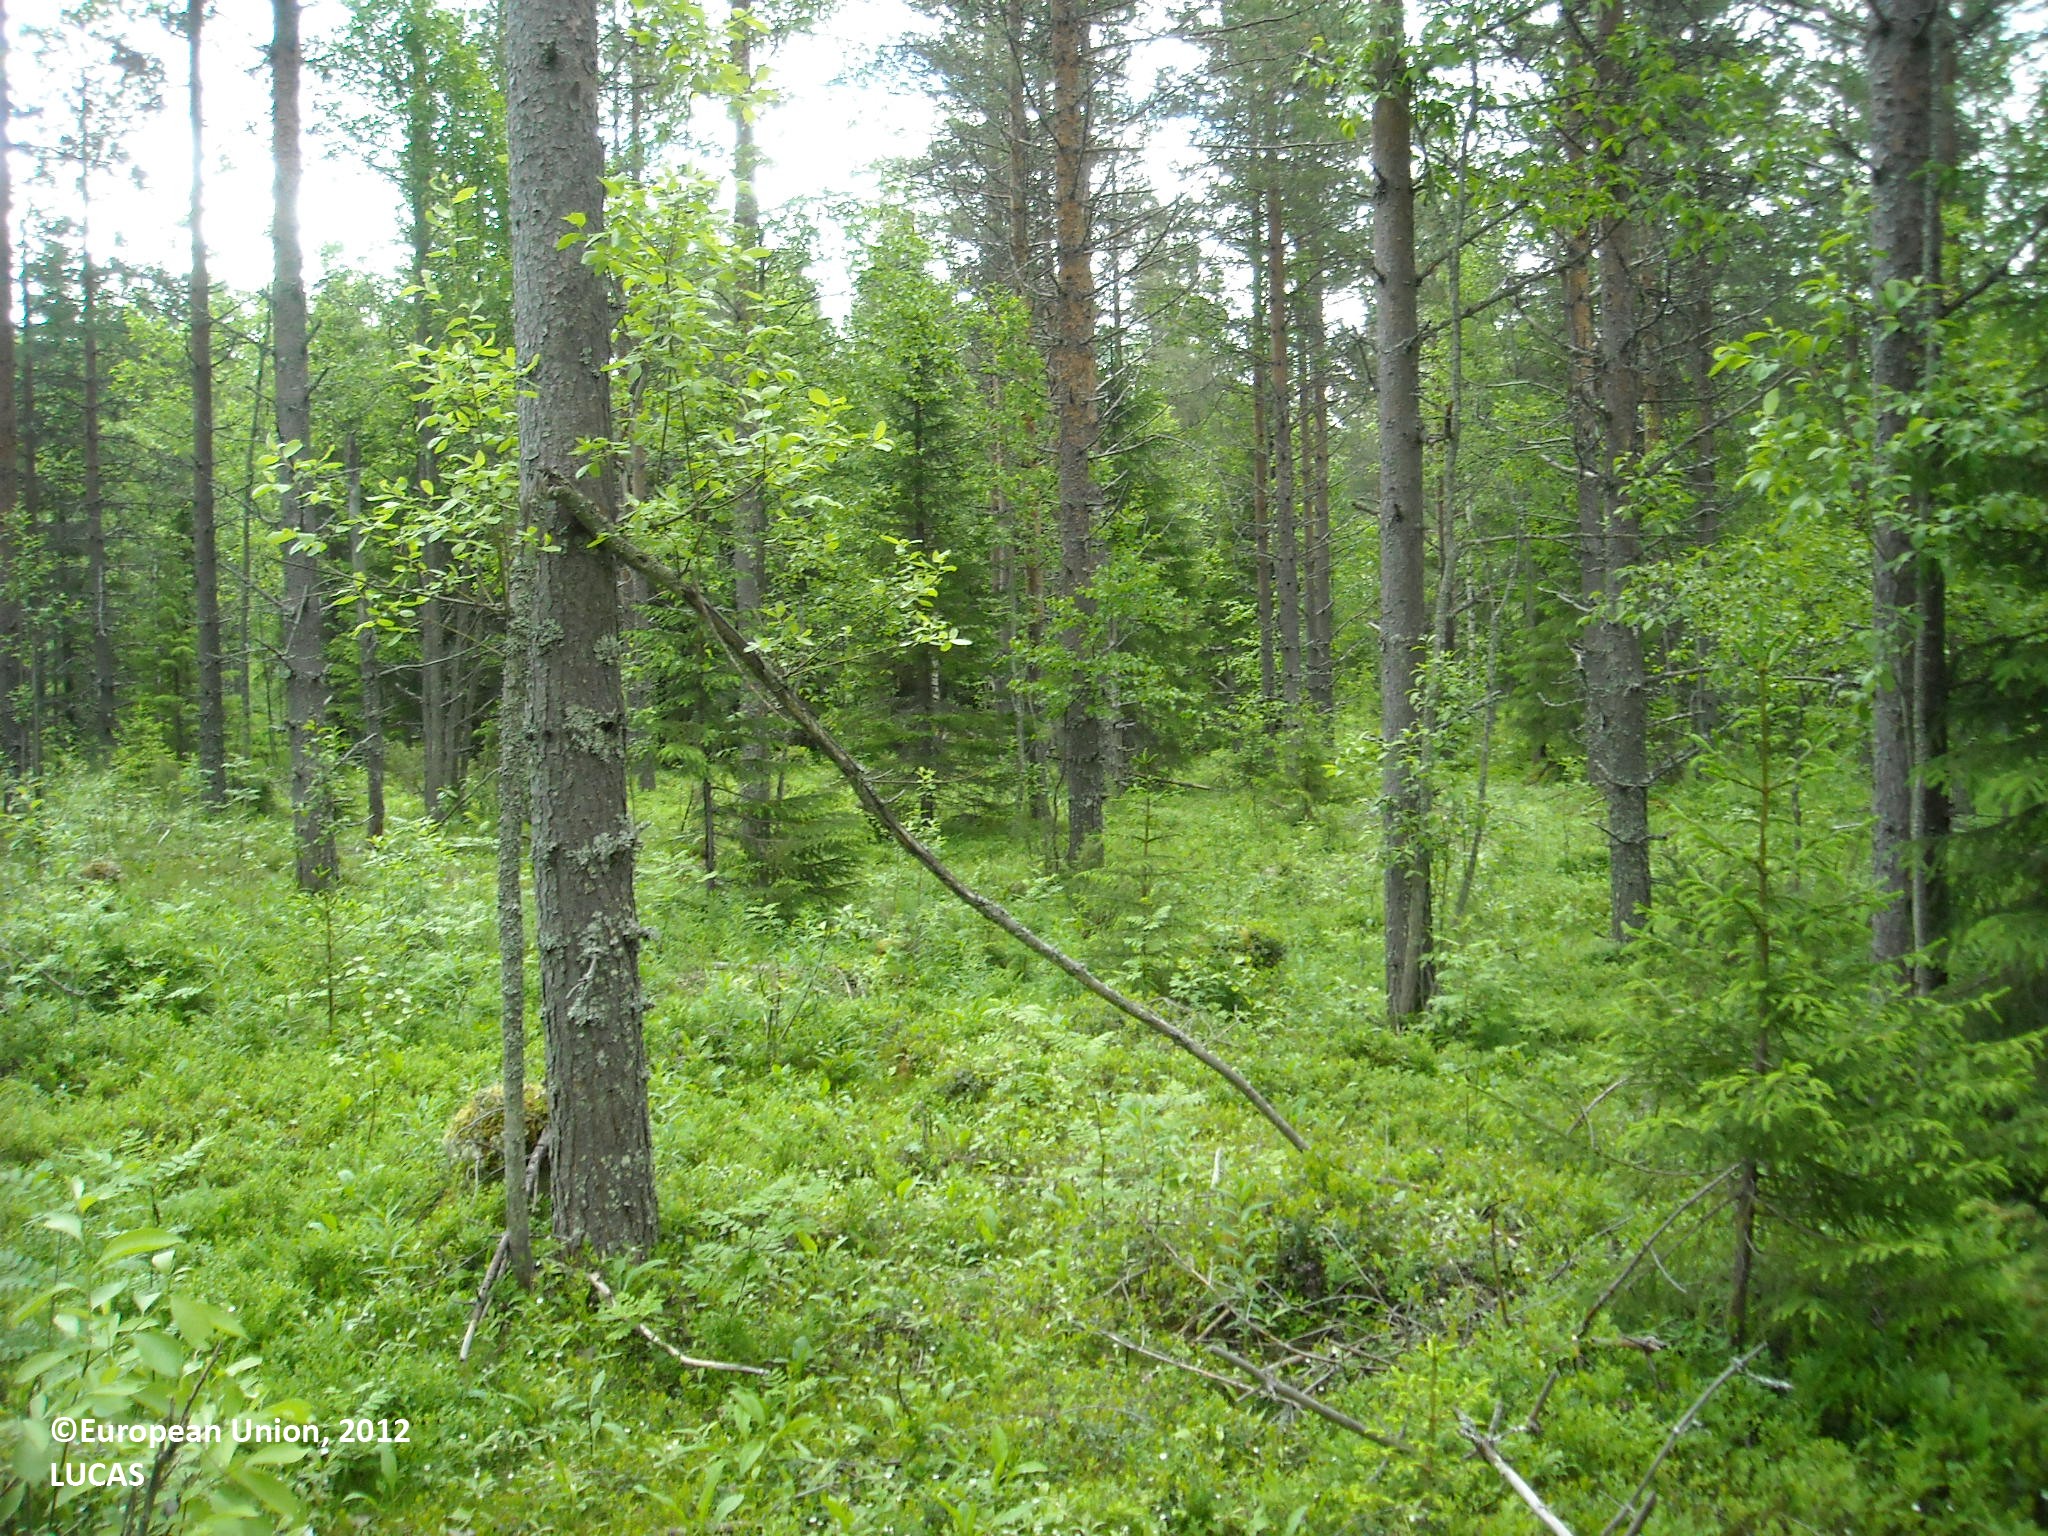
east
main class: Woodland
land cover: Pine dominated coniferous woodland
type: boreal forest
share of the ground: 25 - 50 %
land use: Forestry
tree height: > 5 m
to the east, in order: Pine dominated coniferous woodland; Spruce dominated mixed woodland; Pine dominated mixed woodland; Tracks; Pine dominated mixed woodland; Other mixed woodland; Shrubland with sparse tree cover
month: June
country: FI
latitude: 64.7281
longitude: 27.8920
